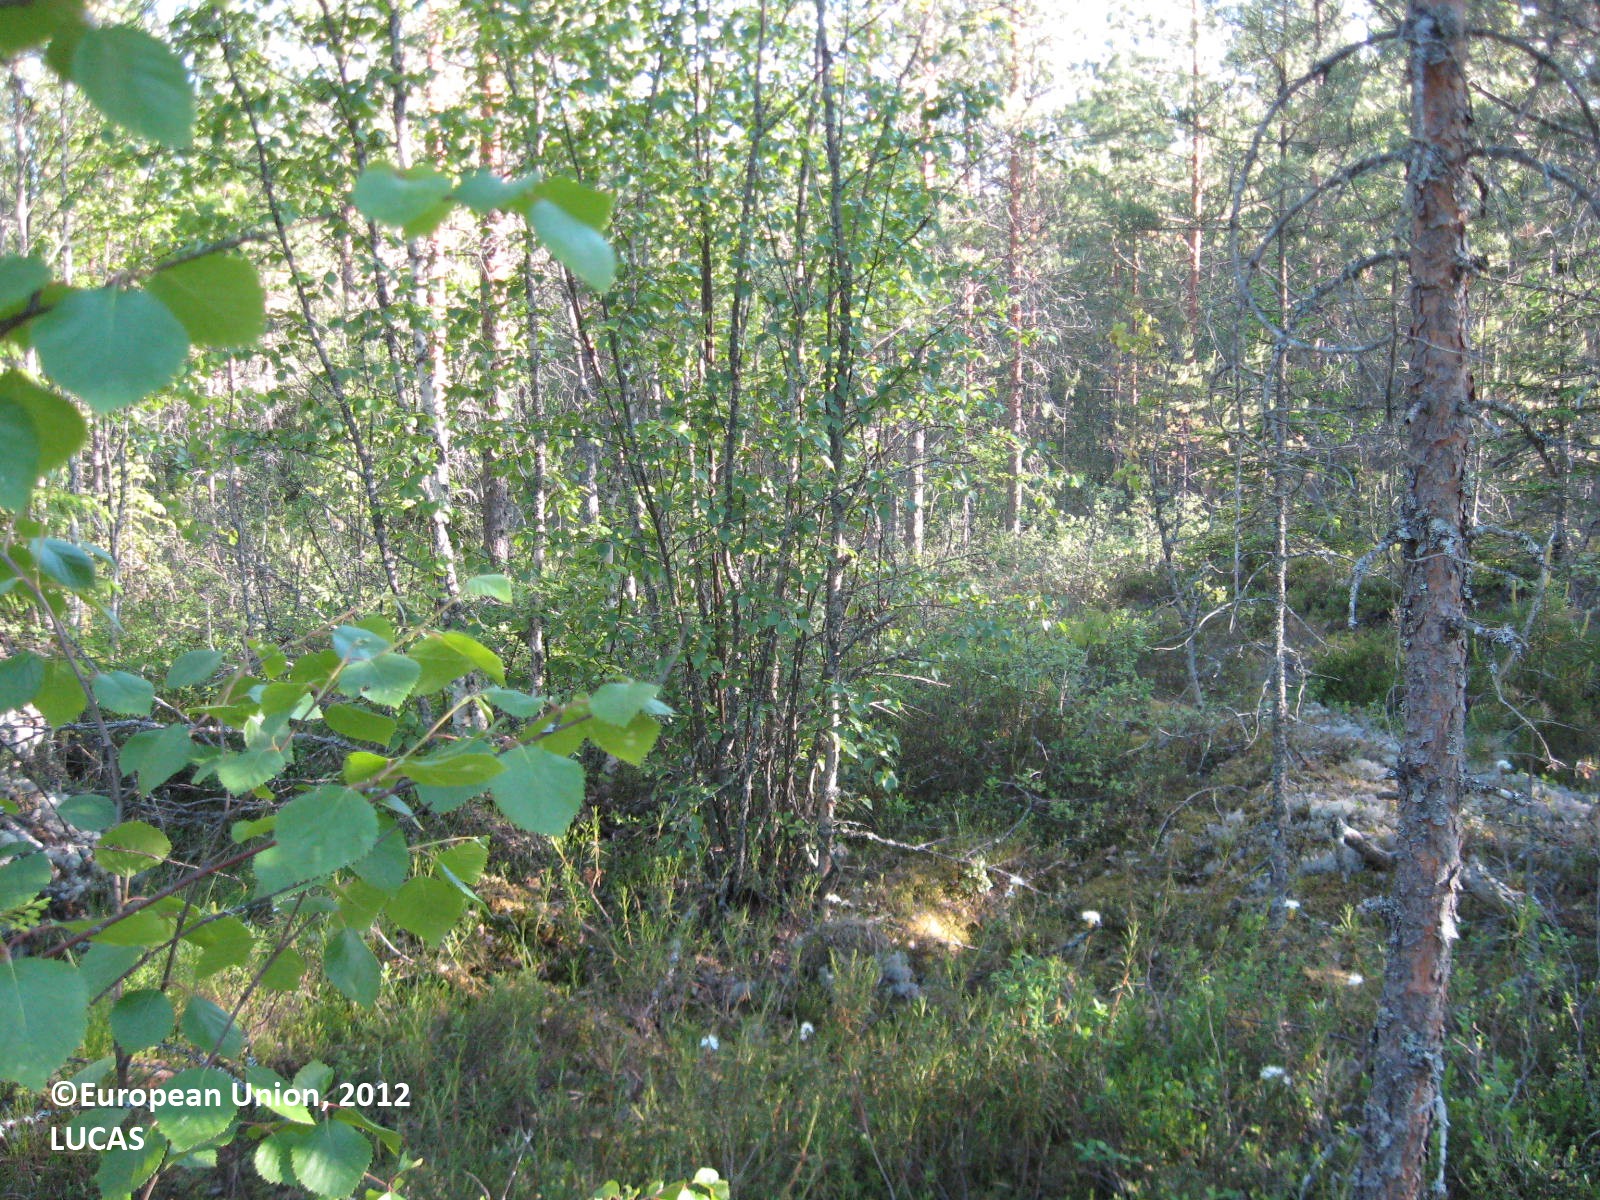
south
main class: Woodland
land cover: Pine dominated coniferous woodland
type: boreal forest
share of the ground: > 75 %
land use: Forestry
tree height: > 5 m
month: June
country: FI
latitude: 62.8584
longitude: 21.5752
